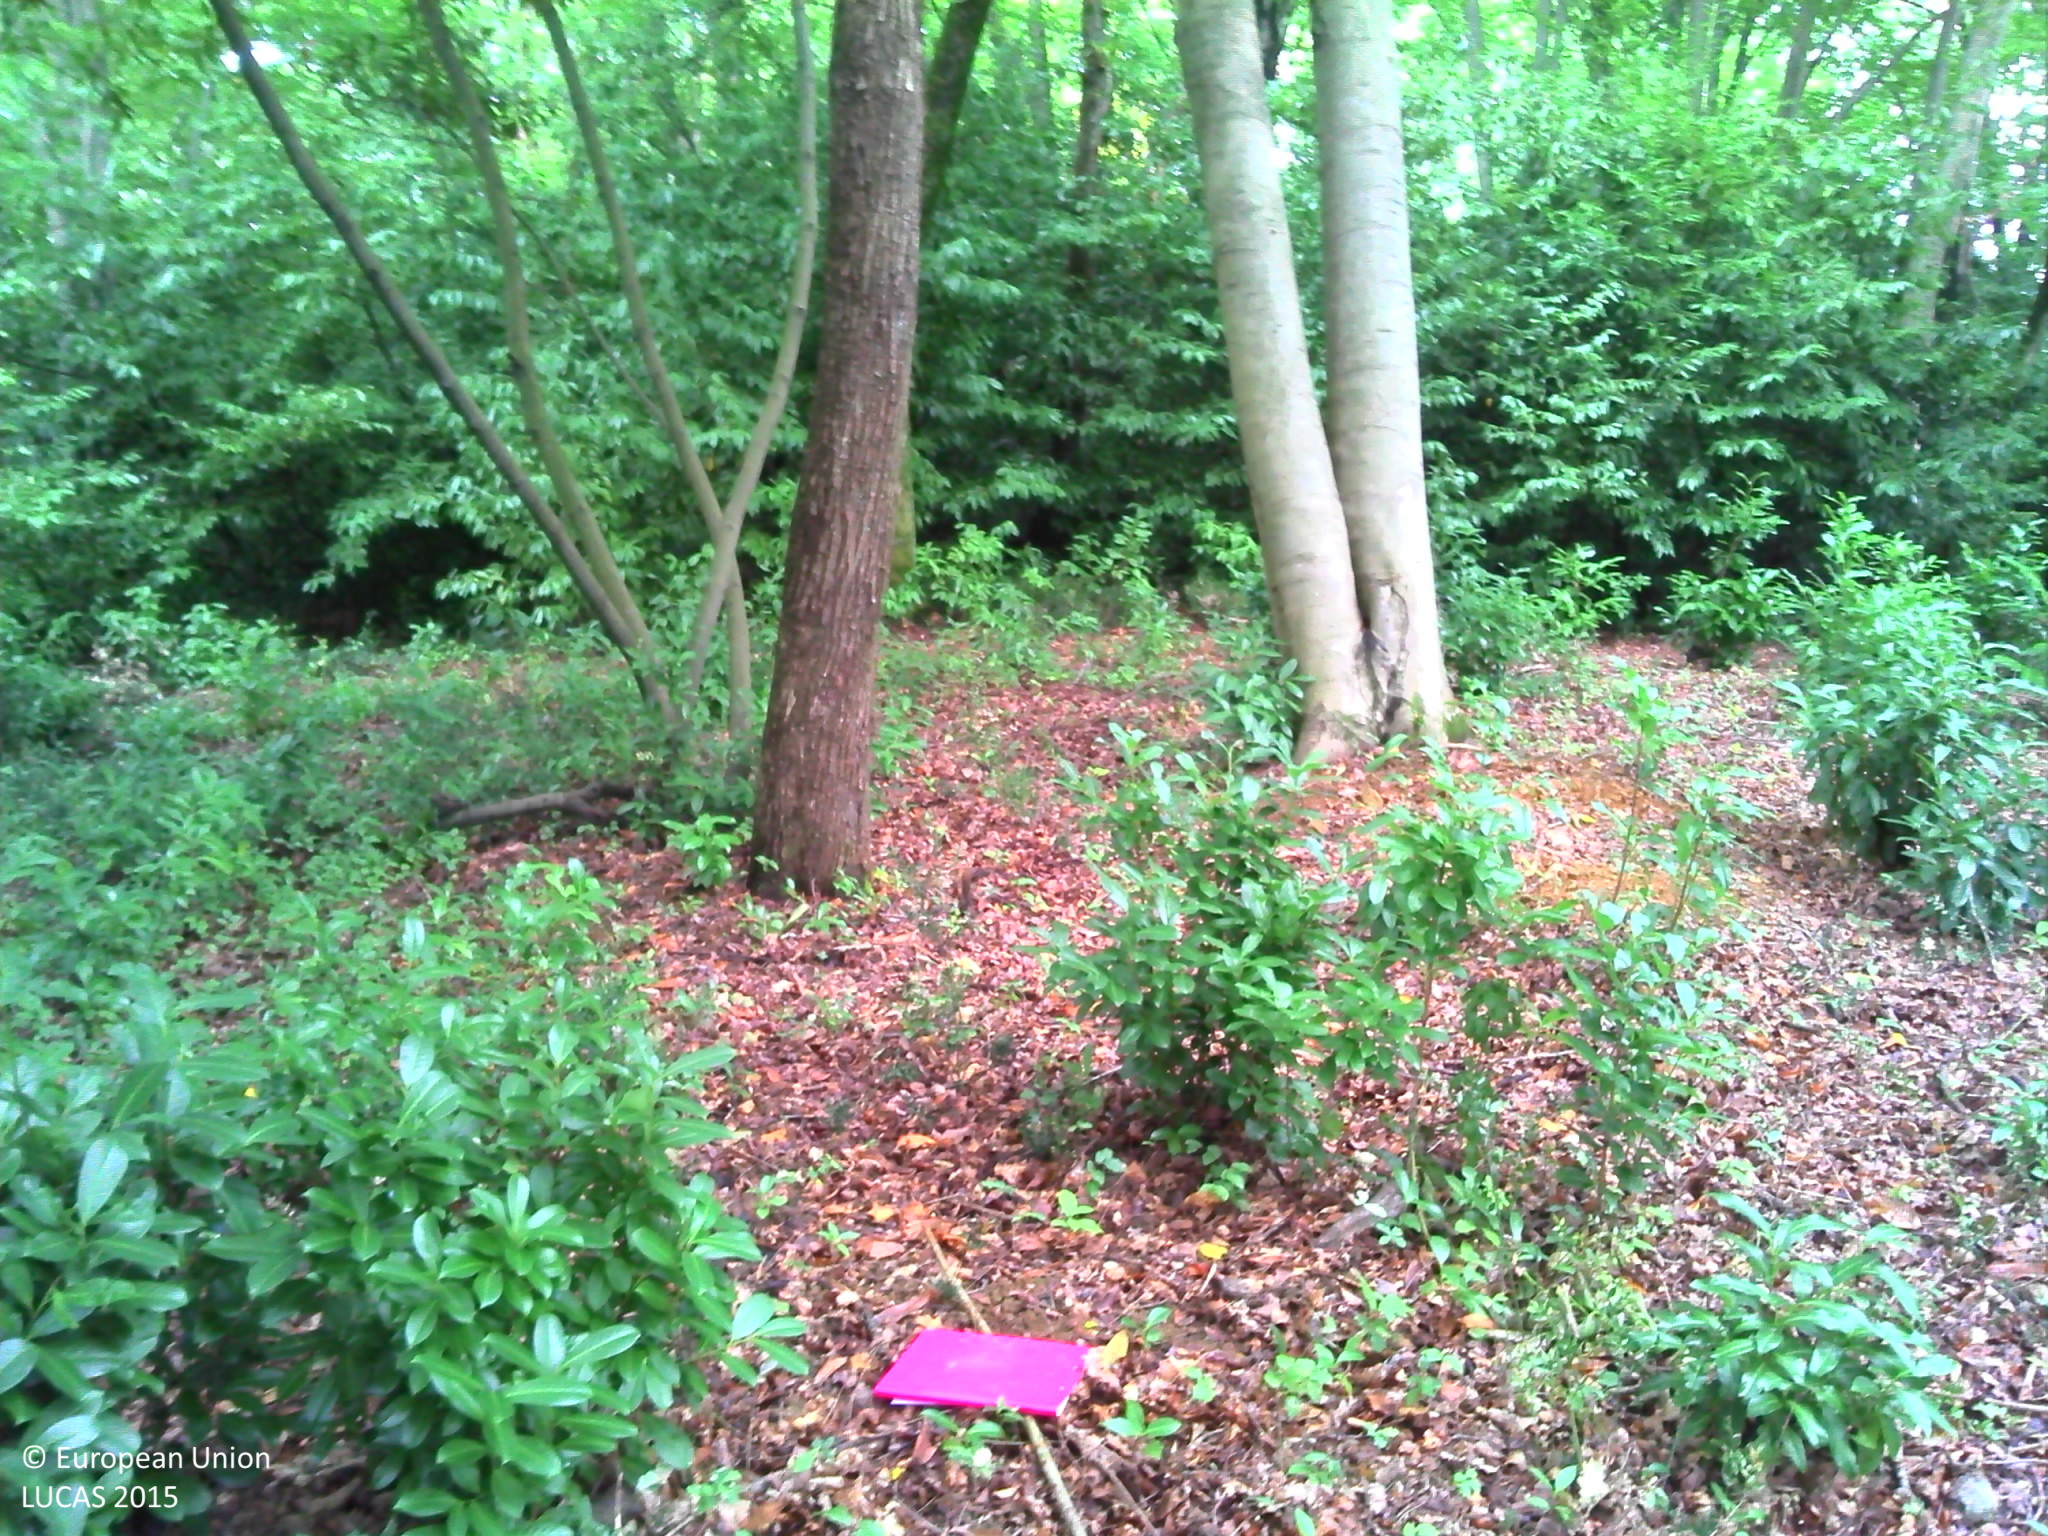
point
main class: Woodland
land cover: Broadleaved woodland
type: acidophilous oak and oak-birch forest
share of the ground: > 75 %
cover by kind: broadleaved forest trees 80 %, shrubs 10 %, herbaceous plants 5 %, lichens and mosses 5 %
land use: Forestry
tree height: > 5 m
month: September
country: FR
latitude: 43.2818
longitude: -0.3953
